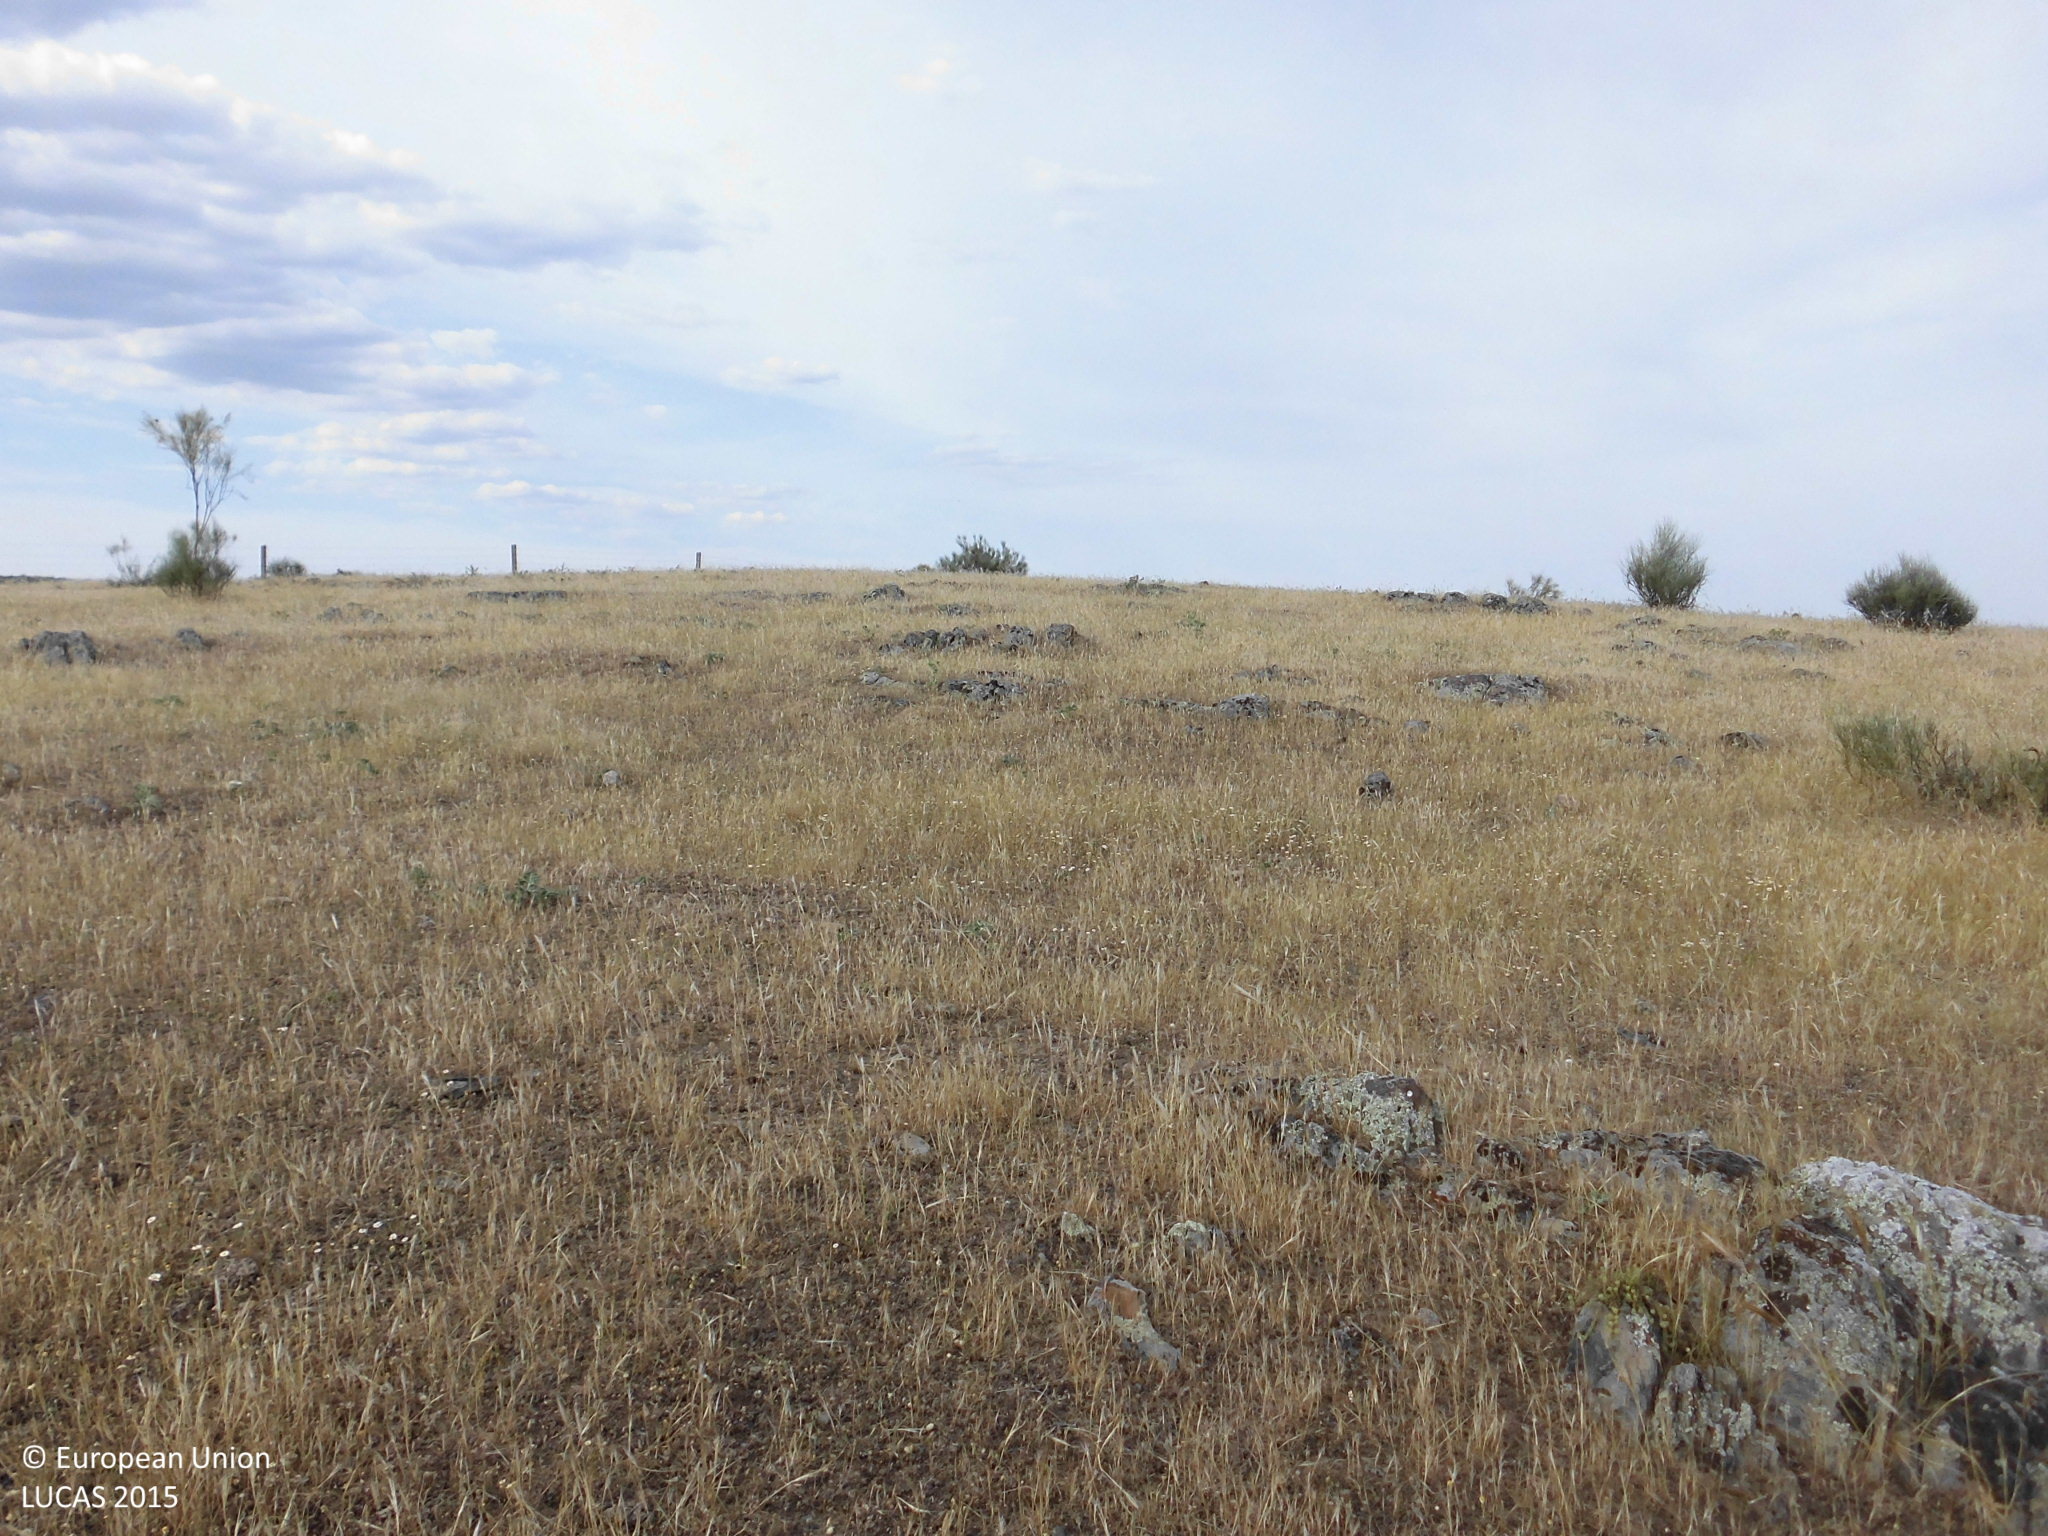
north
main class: Grassland
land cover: Grassland without tree/shrub cover
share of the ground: > 75 %
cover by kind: herbaceous plants 95 %, shrubs 5 %
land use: Agriculture (excluding fallow land and kitchen gardens)
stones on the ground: < 10 %
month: May
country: ES
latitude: 39.5592
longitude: -6.0667
